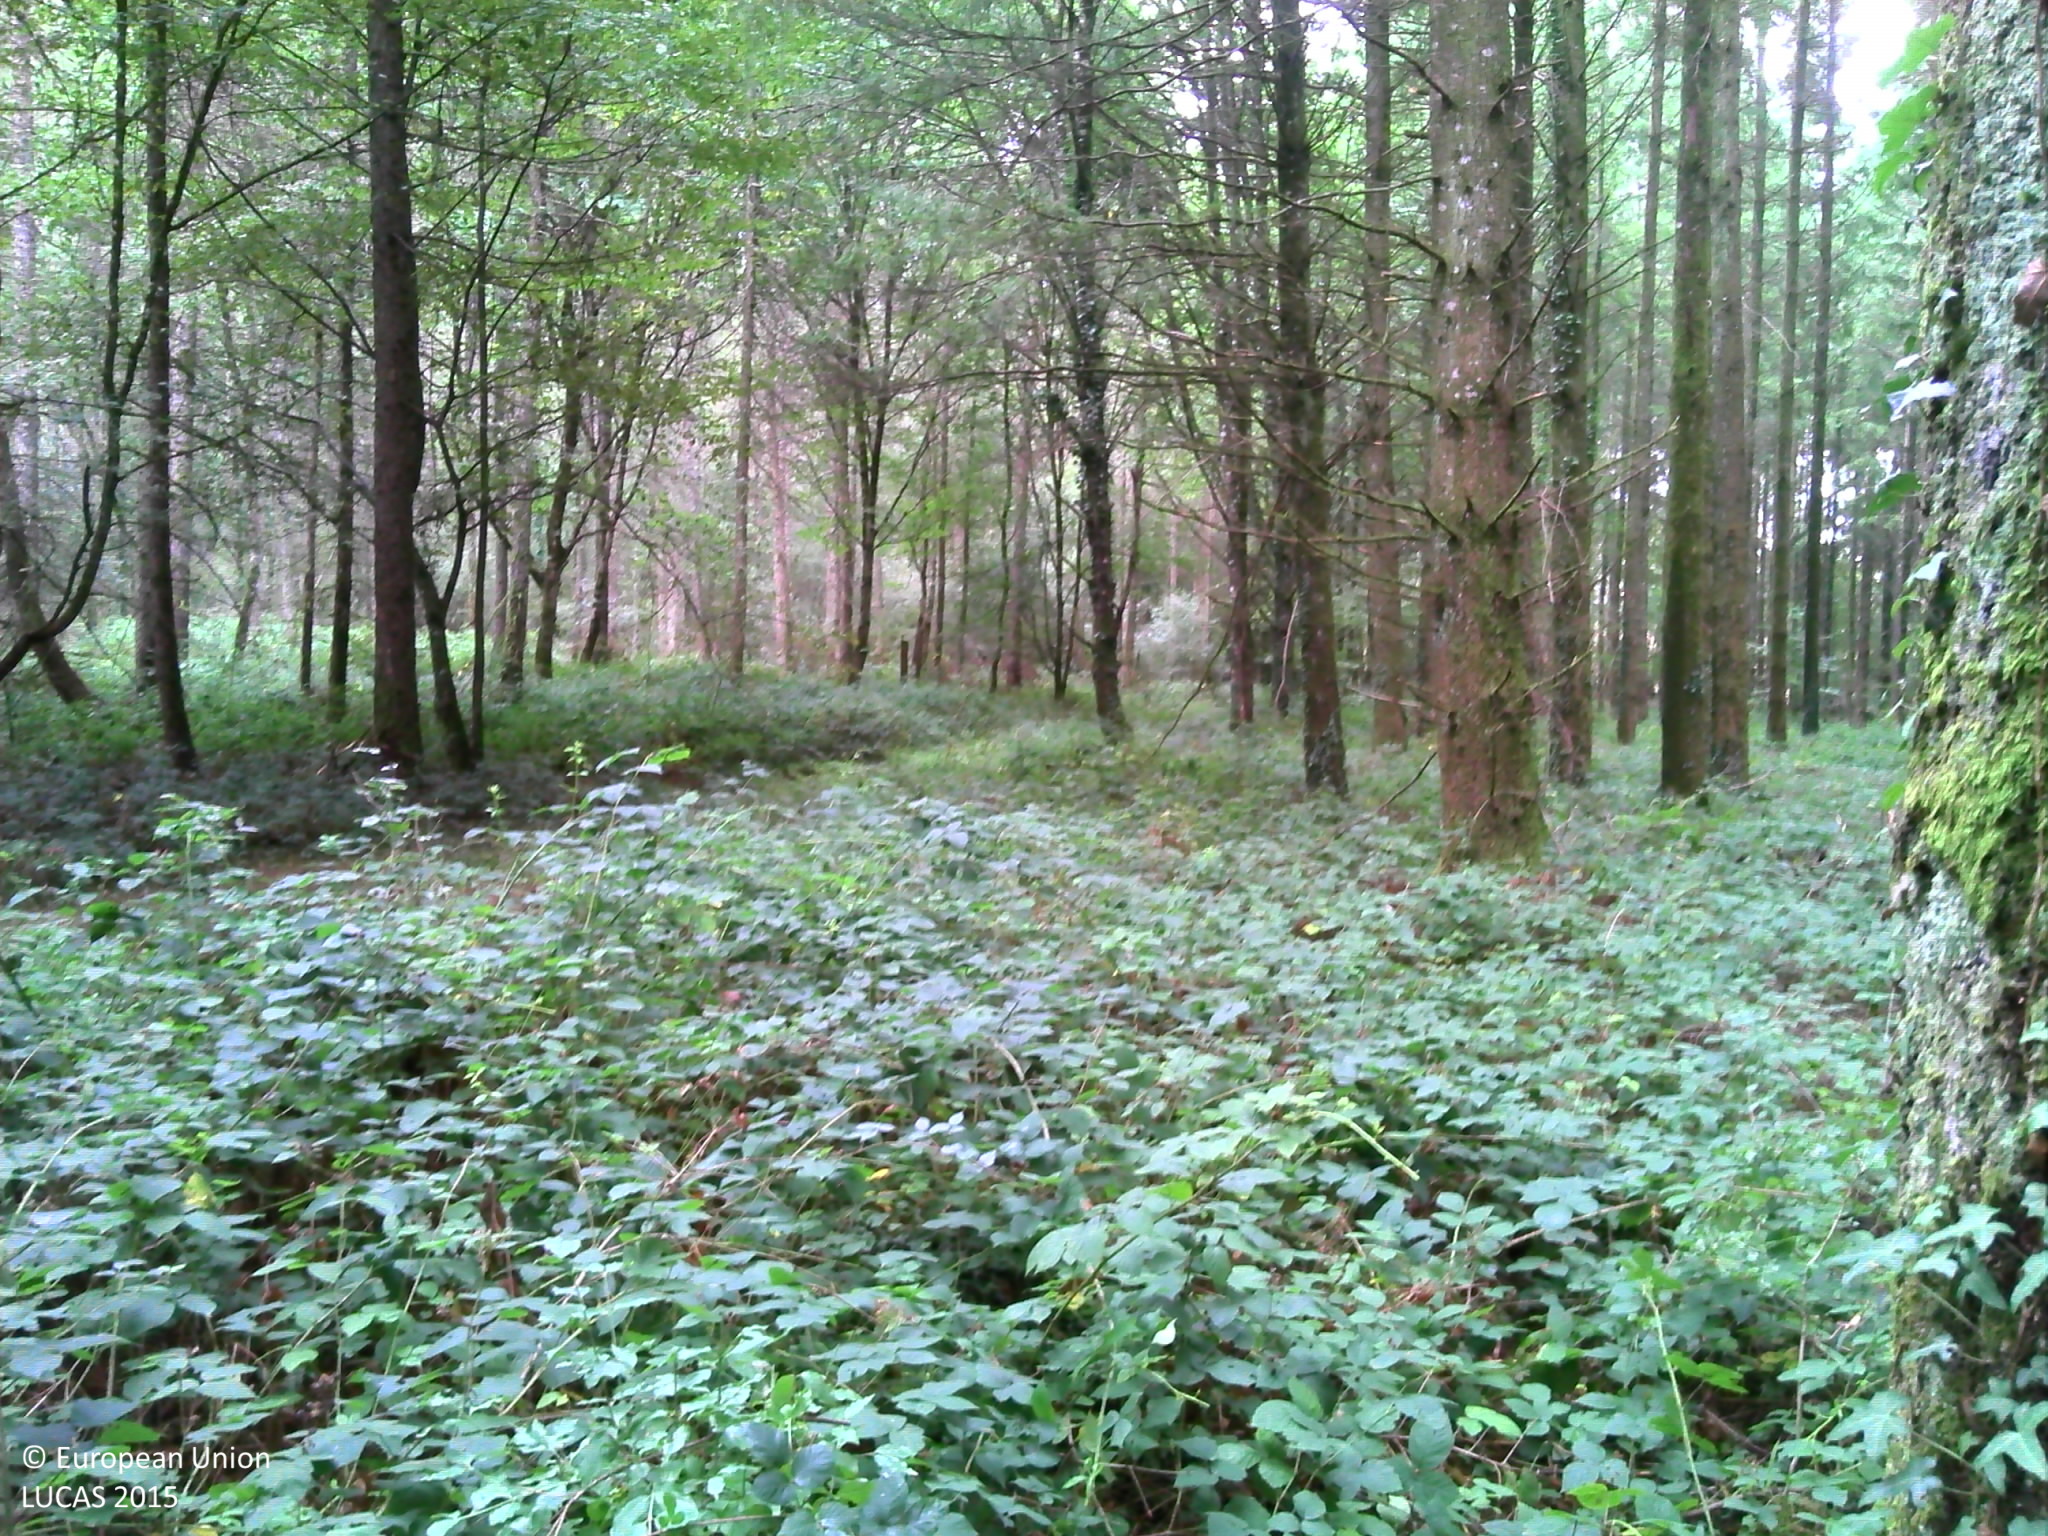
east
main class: Woodland
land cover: Other coniferous woodland
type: exotic forest
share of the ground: > 75 %
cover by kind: coniferous forest trees 90 %, herbaceous plants 5 %, lichens and mosses 5 %
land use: Forestry
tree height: > 5 m
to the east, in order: Other coniferous woodland; Tracks; Other coniferous woodland; Spontaneously vegetated surfaces; Lines of trees; Grassland without tree/shrub cover; Common wheat
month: September
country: FR
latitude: 47.7749
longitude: 4.4068
